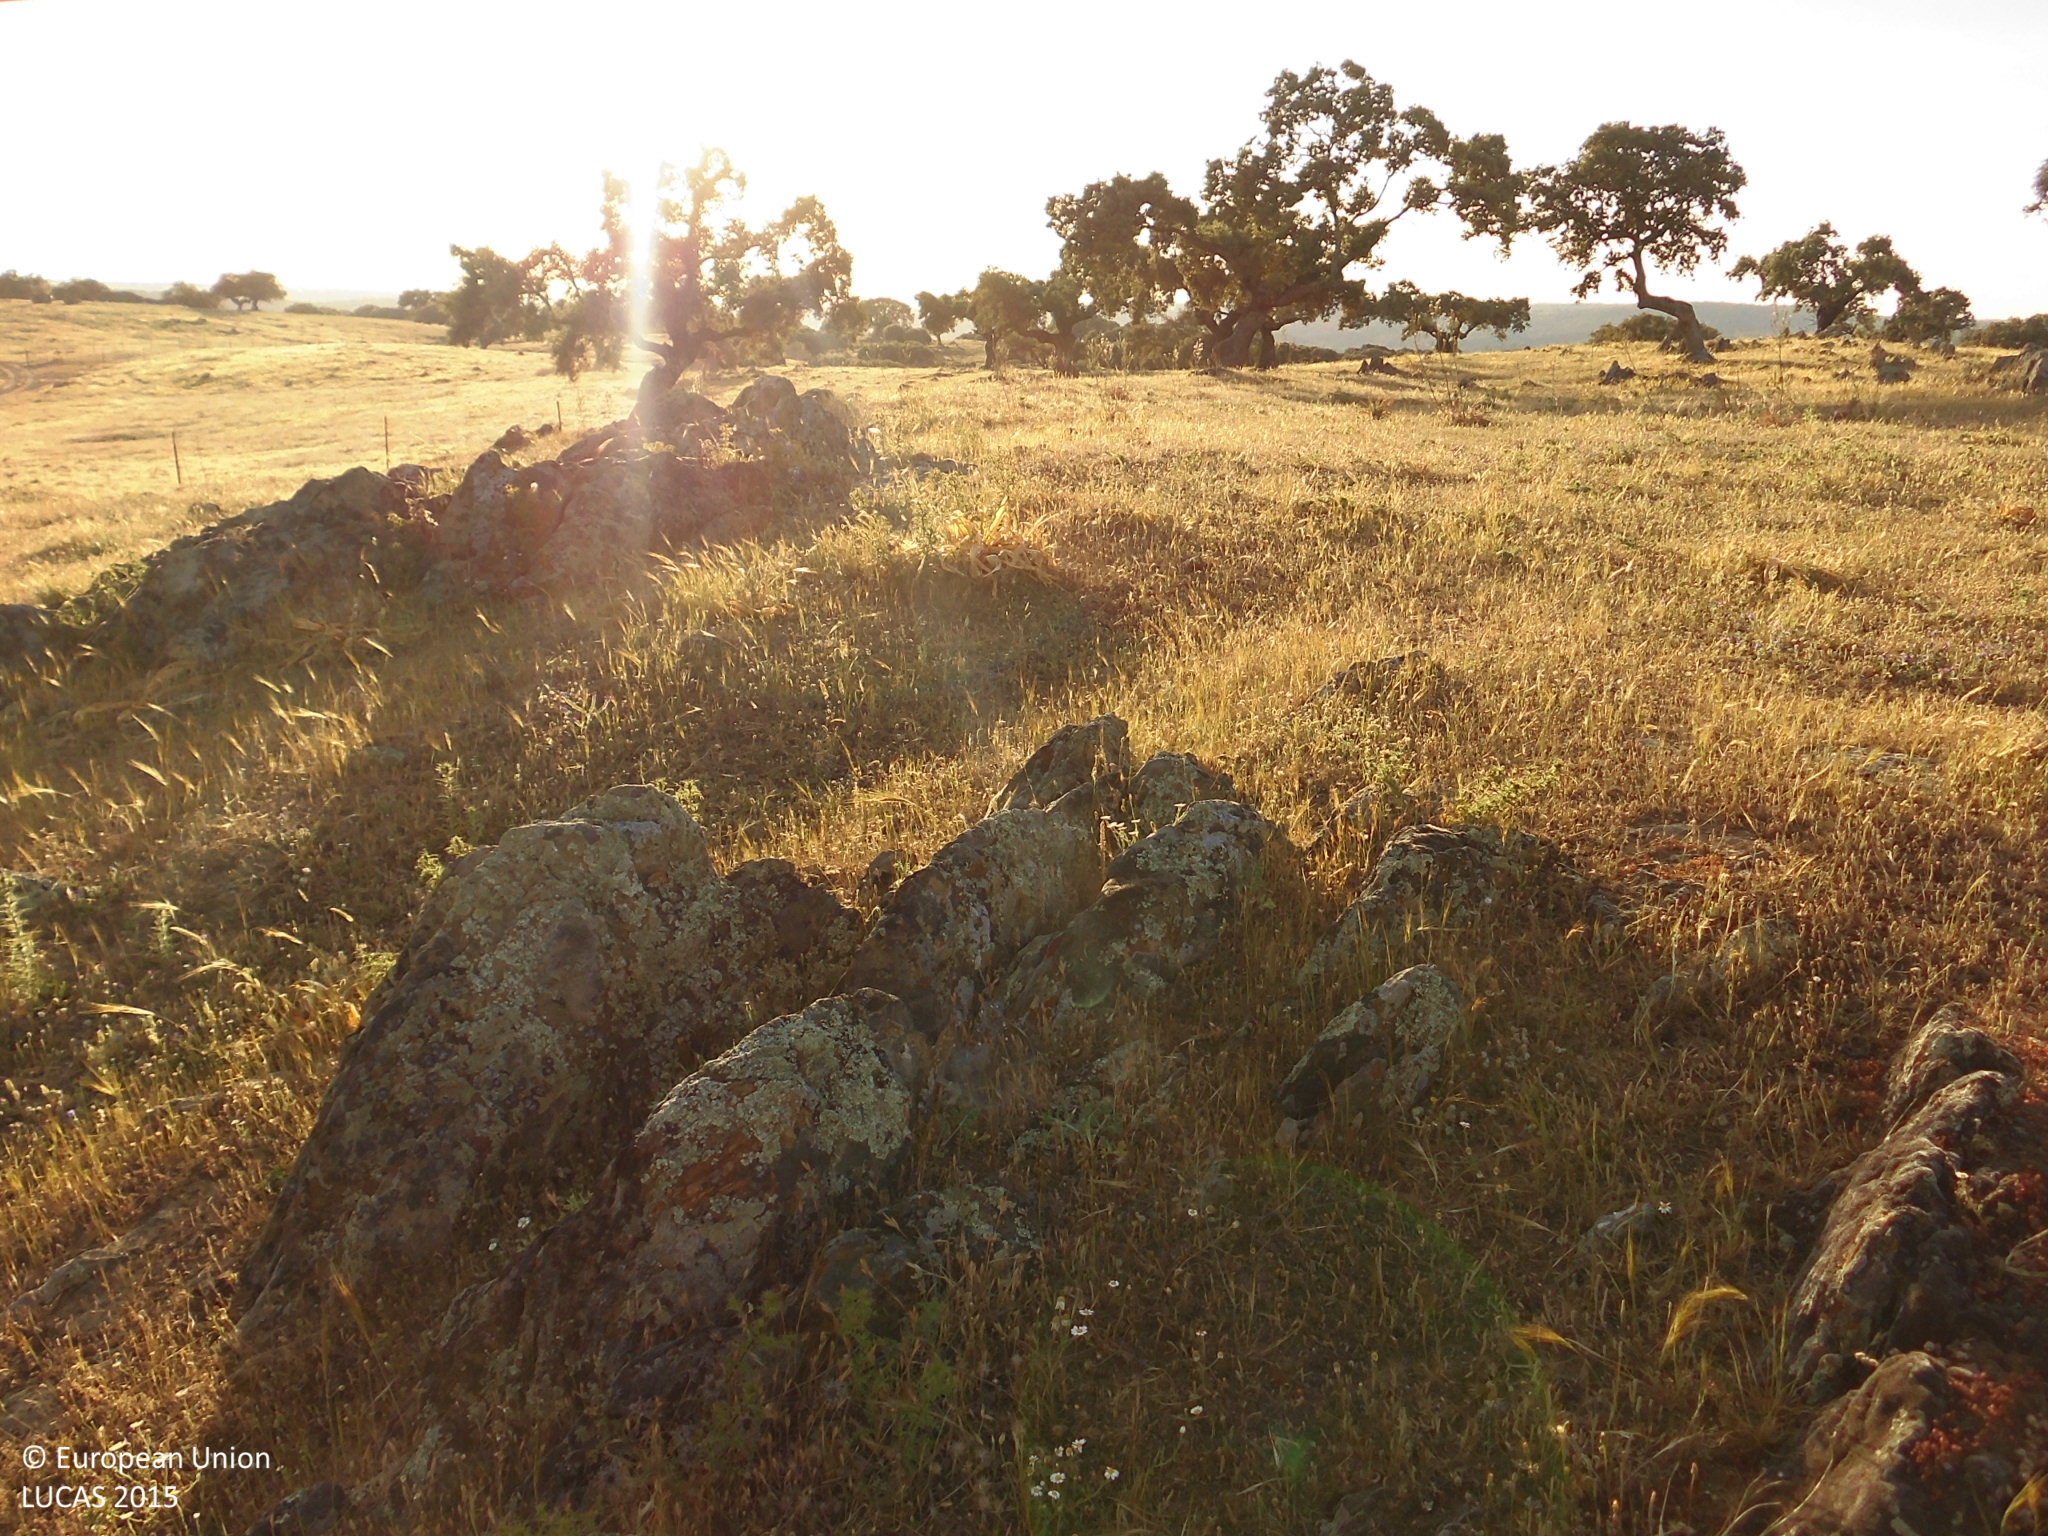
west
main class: Grassland
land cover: Grassland without tree/shrub cover
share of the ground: > 75 %
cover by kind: herbaceous plants 100 %
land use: Agriculture (excluding fallow land and kitchen gardens)
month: May
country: ES
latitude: 39.5907
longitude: -6.0984
